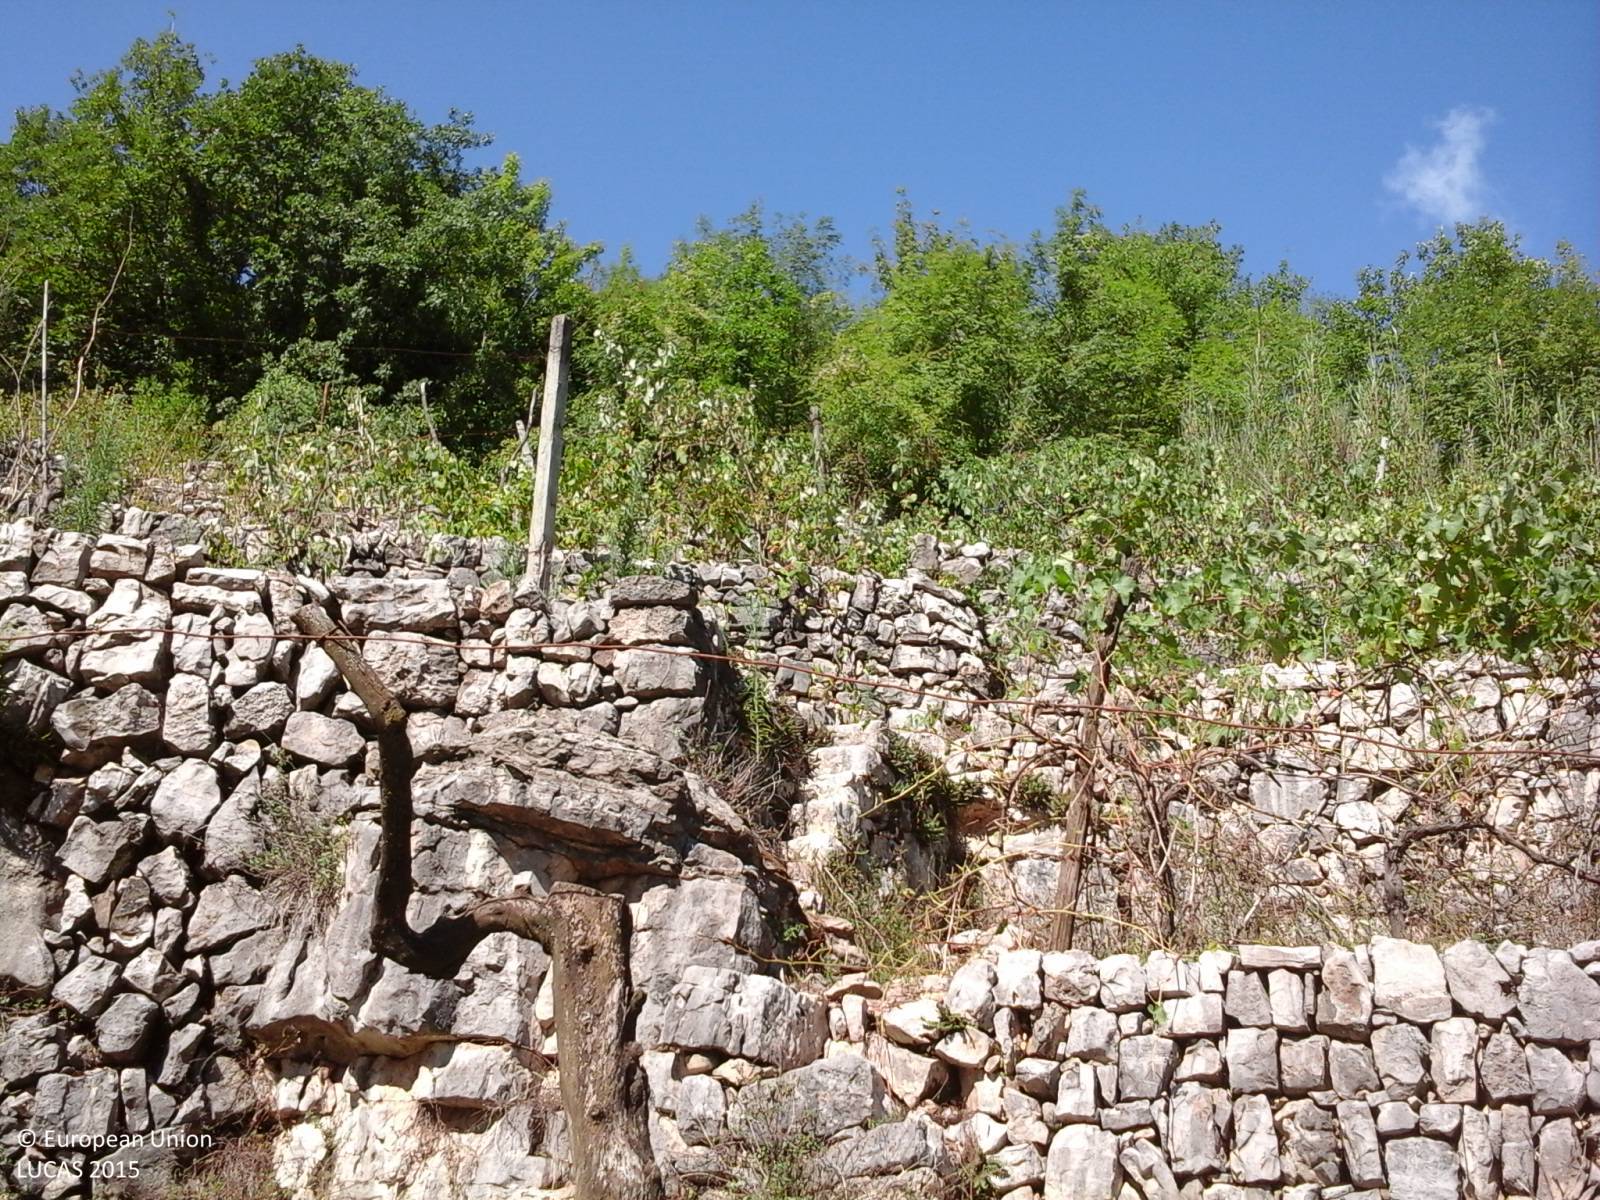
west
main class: Cropland
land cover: Vineyards
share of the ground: 25 - 50 %
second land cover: Spontaneously vegetated surfaces
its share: > 75 %
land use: Agriculture (excluding fallow land and kitchen gardens)
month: August
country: IT
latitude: 41.4577
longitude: 13.3987
